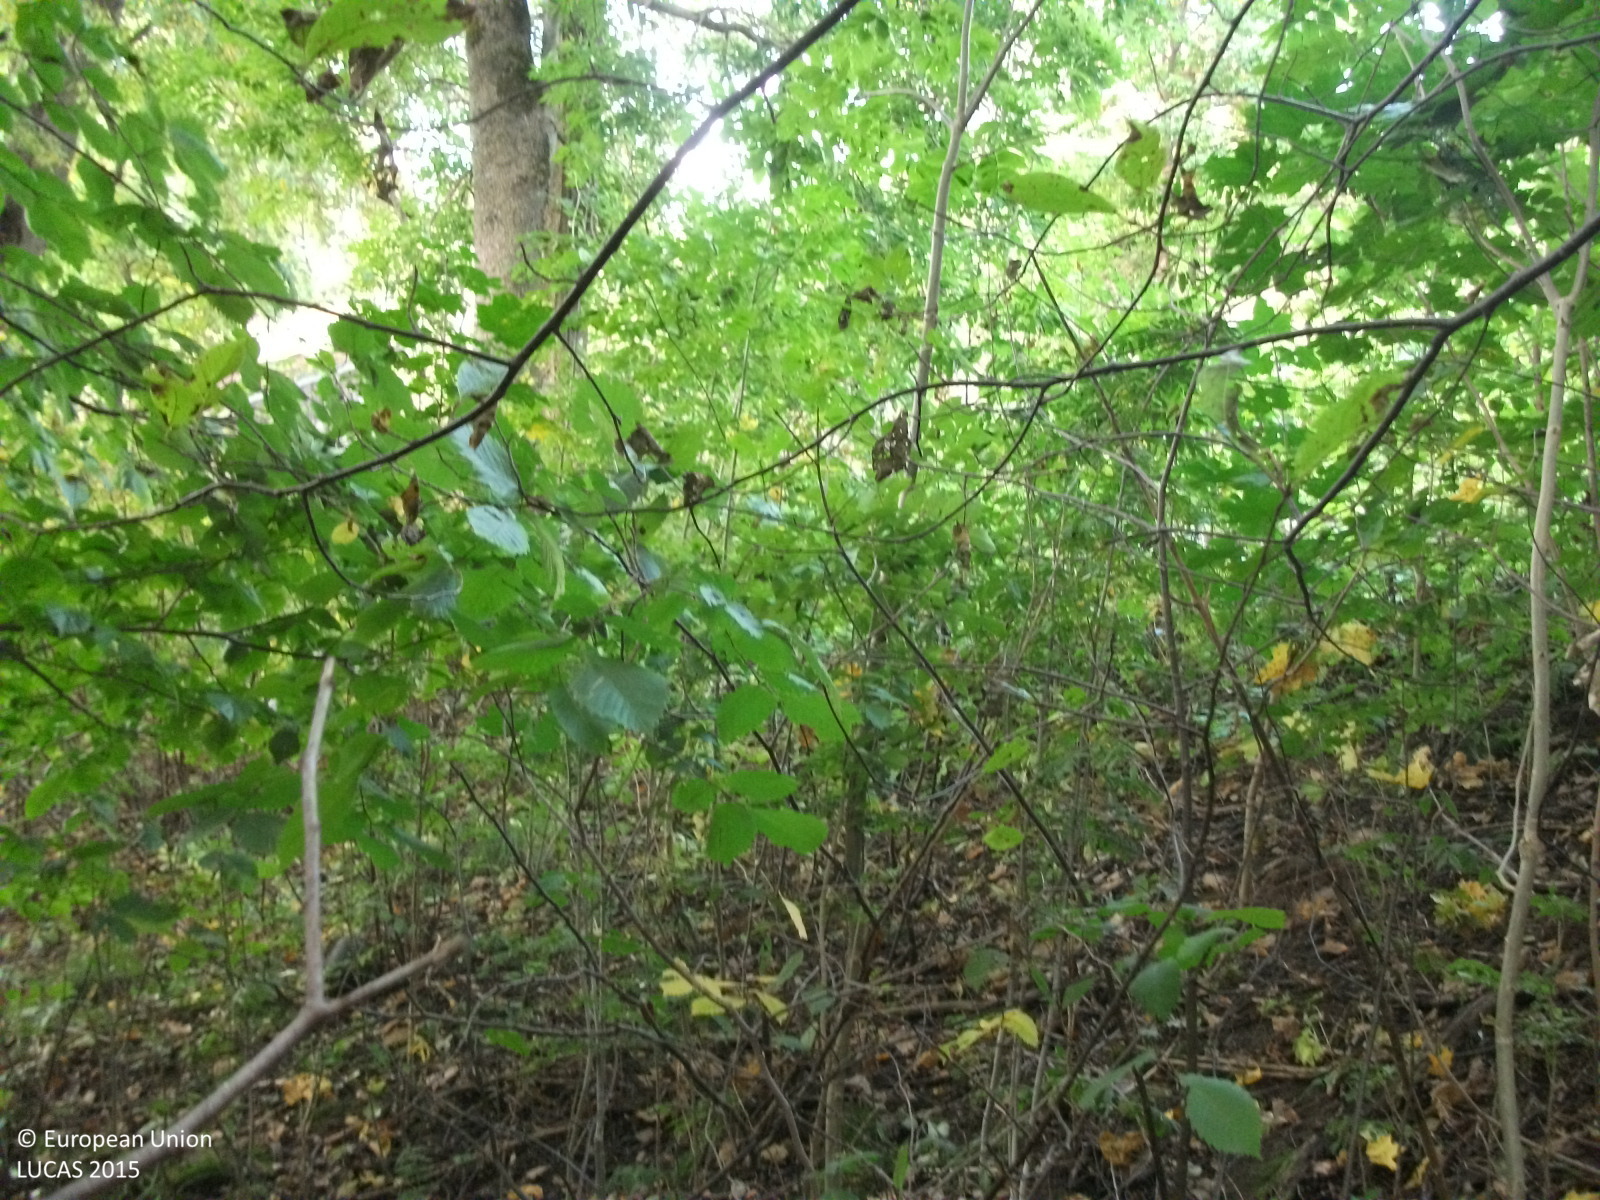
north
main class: Woodland
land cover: Broadleaved woodland
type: non-riverine alder, birch or aspen forest
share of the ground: > 75 %
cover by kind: broadleaved forest trees 90 %, herbaceous plants 5 %, unconsolidated bare surface 5 %
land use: Semi-natural and natural areas not in use
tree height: > 5 m
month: September
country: LV
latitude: 57.8872
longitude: 24.6477
